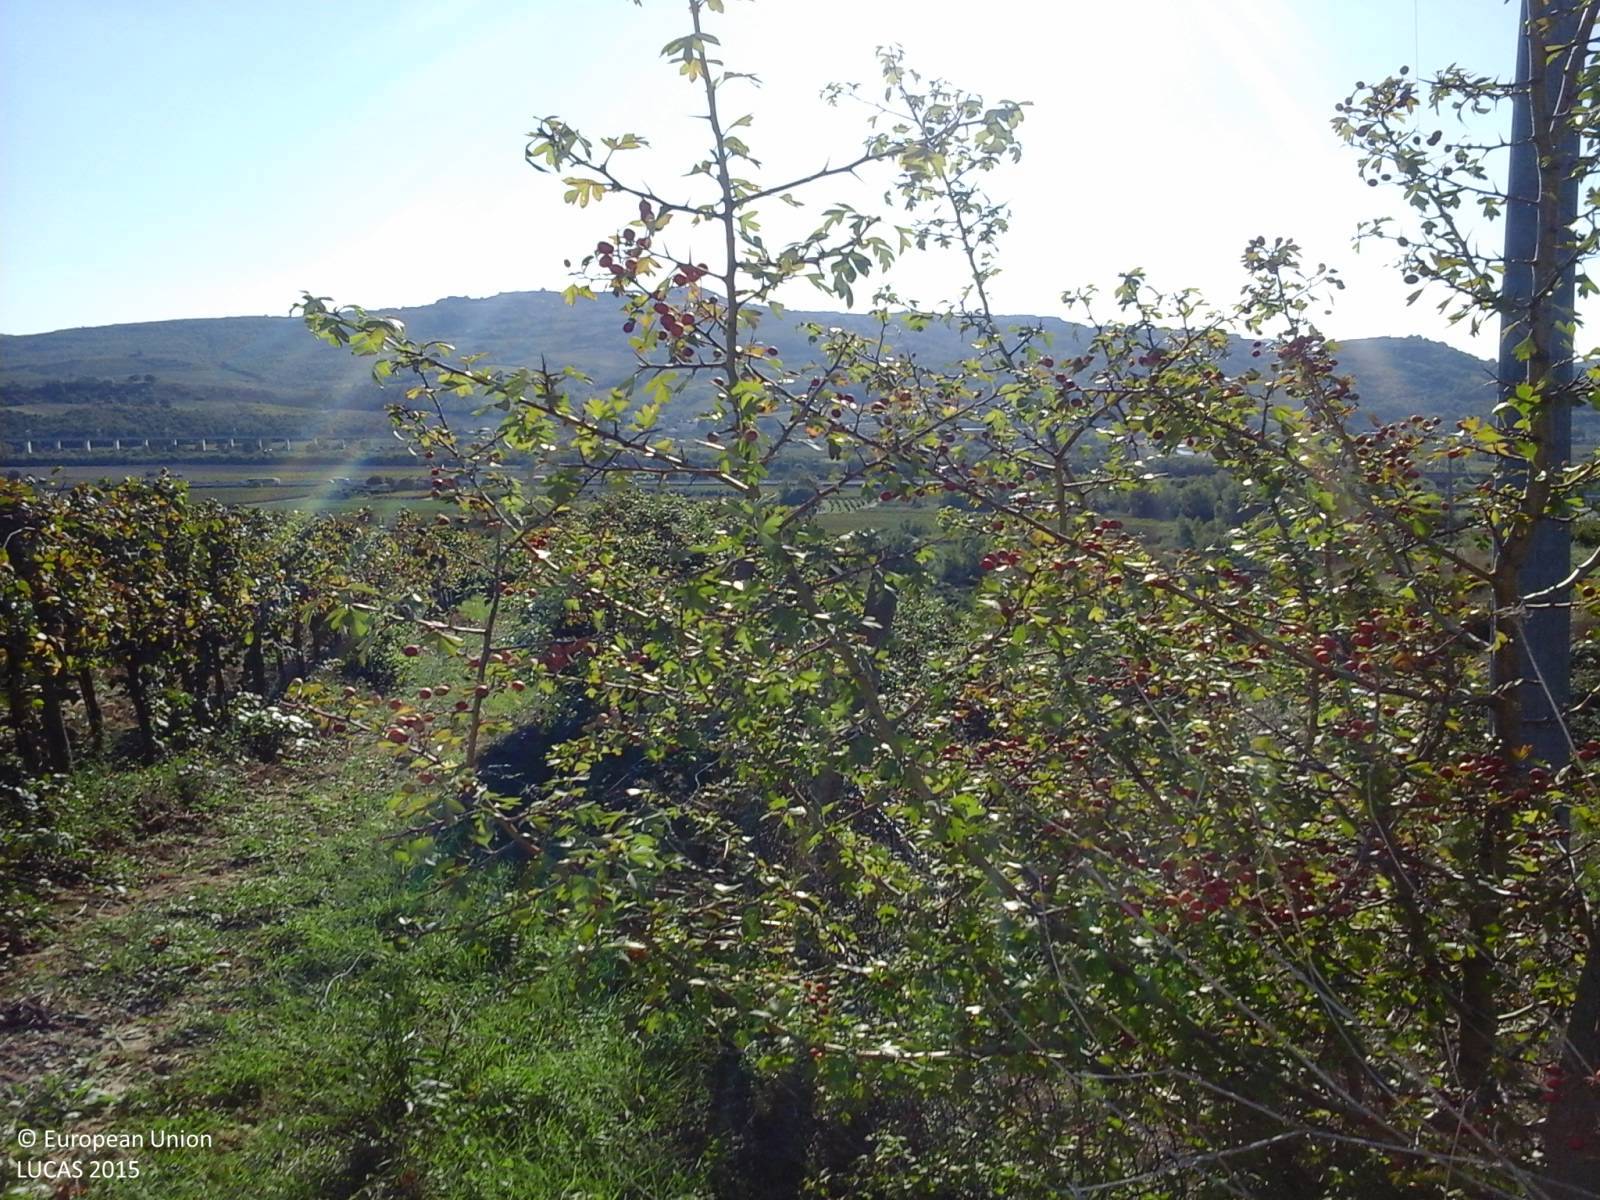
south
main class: Grassland
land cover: Grassland with sparse tree/shrub cover
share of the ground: > 75 %
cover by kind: herbaceous plants 90 %, broadleaved forest trees 5 %, shrubs 5 %
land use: Semi-natural and natural areas not in use
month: September
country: IT
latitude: 42.7776
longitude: 12.0591
